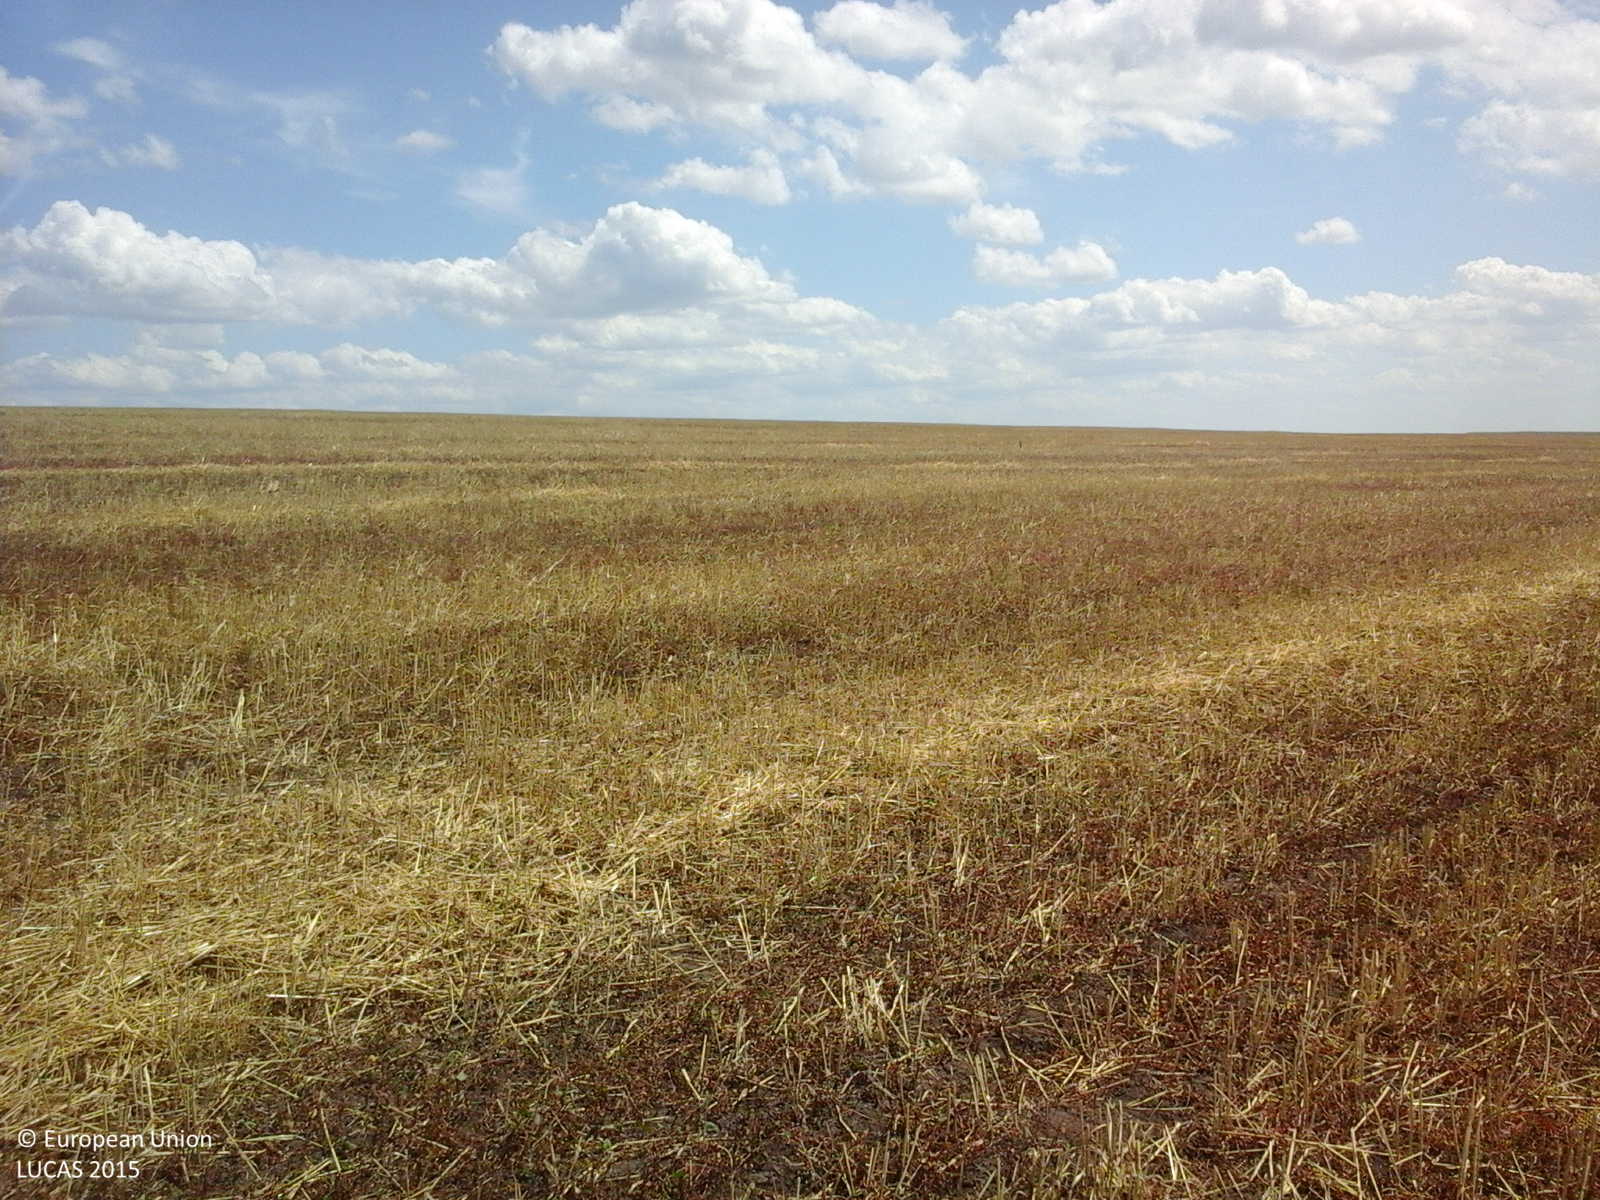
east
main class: Cropland
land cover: Common wheat
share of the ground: > 75 %
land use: Agriculture (excluding fallow land and kitchen gardens)
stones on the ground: < 10 %
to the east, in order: Common wheat
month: July
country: RO
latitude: 46.4051
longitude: 27.9309
